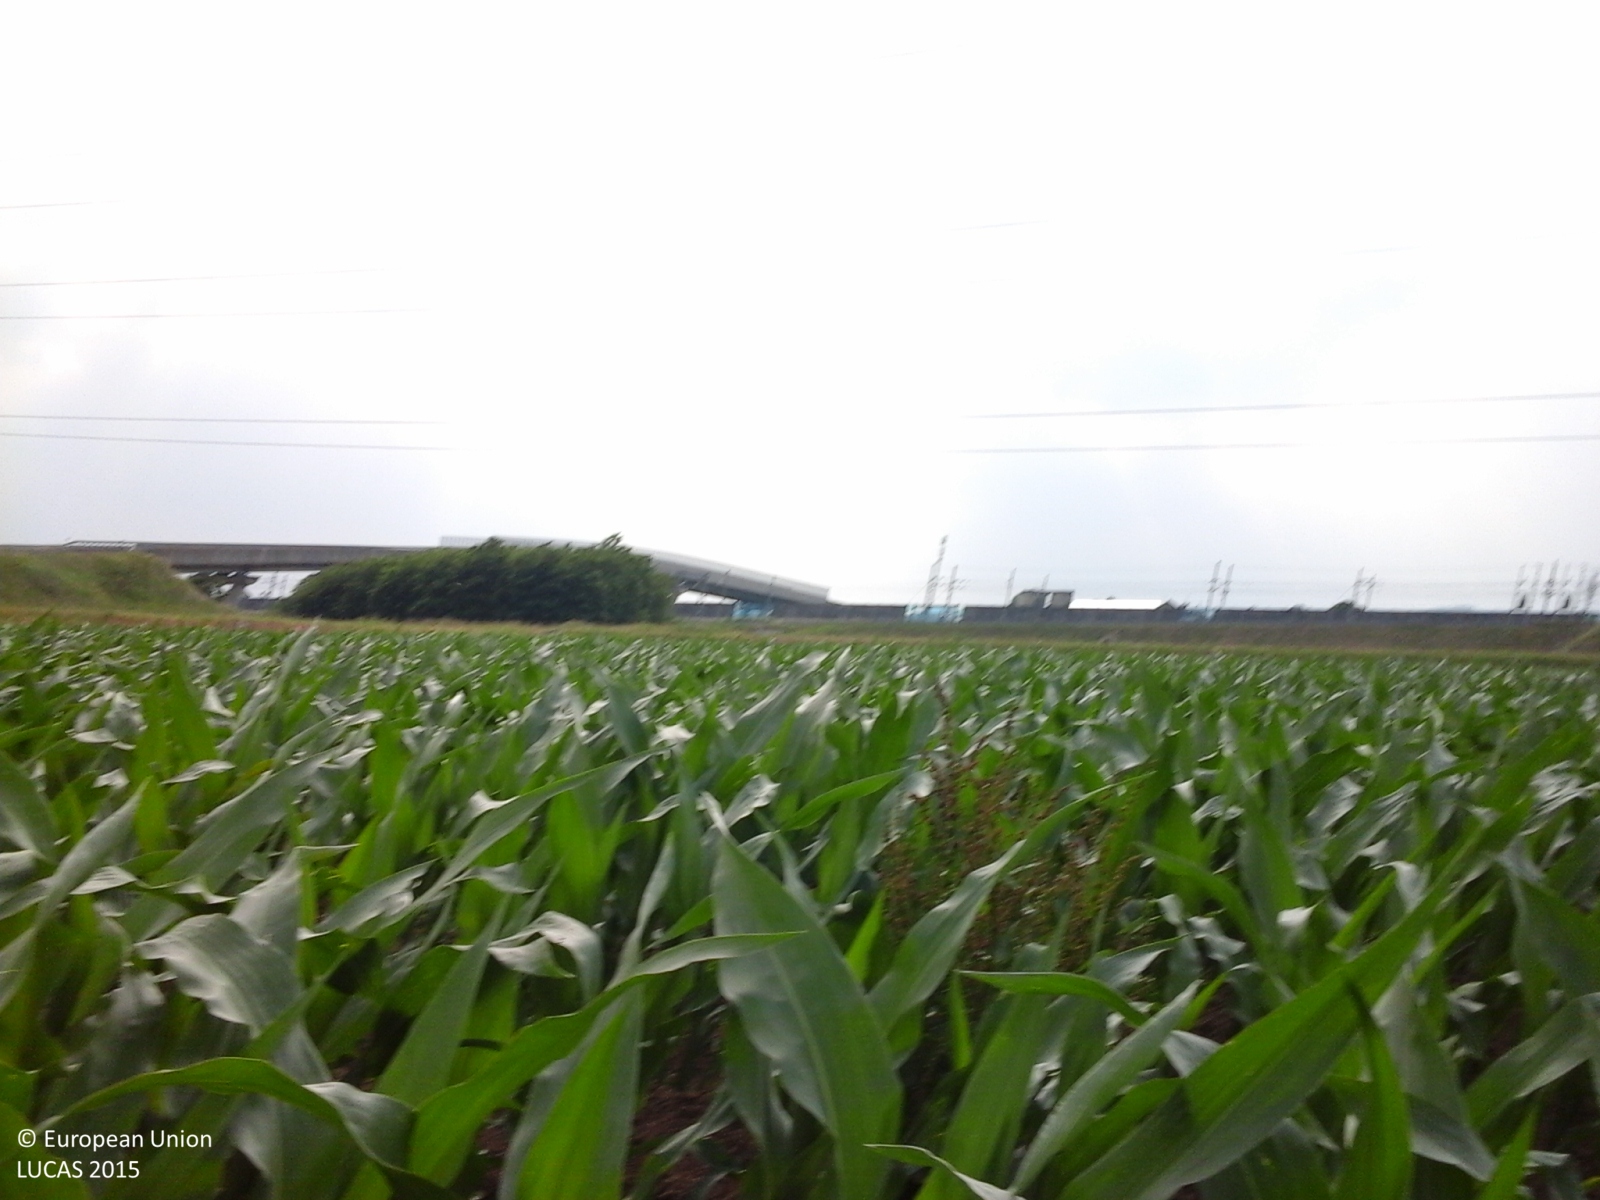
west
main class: Cropland
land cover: Maize
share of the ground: > 75 %
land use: Agriculture (excluding fallow land and kitchen gardens)
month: May
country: IT
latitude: 45.3431
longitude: 8.1016
